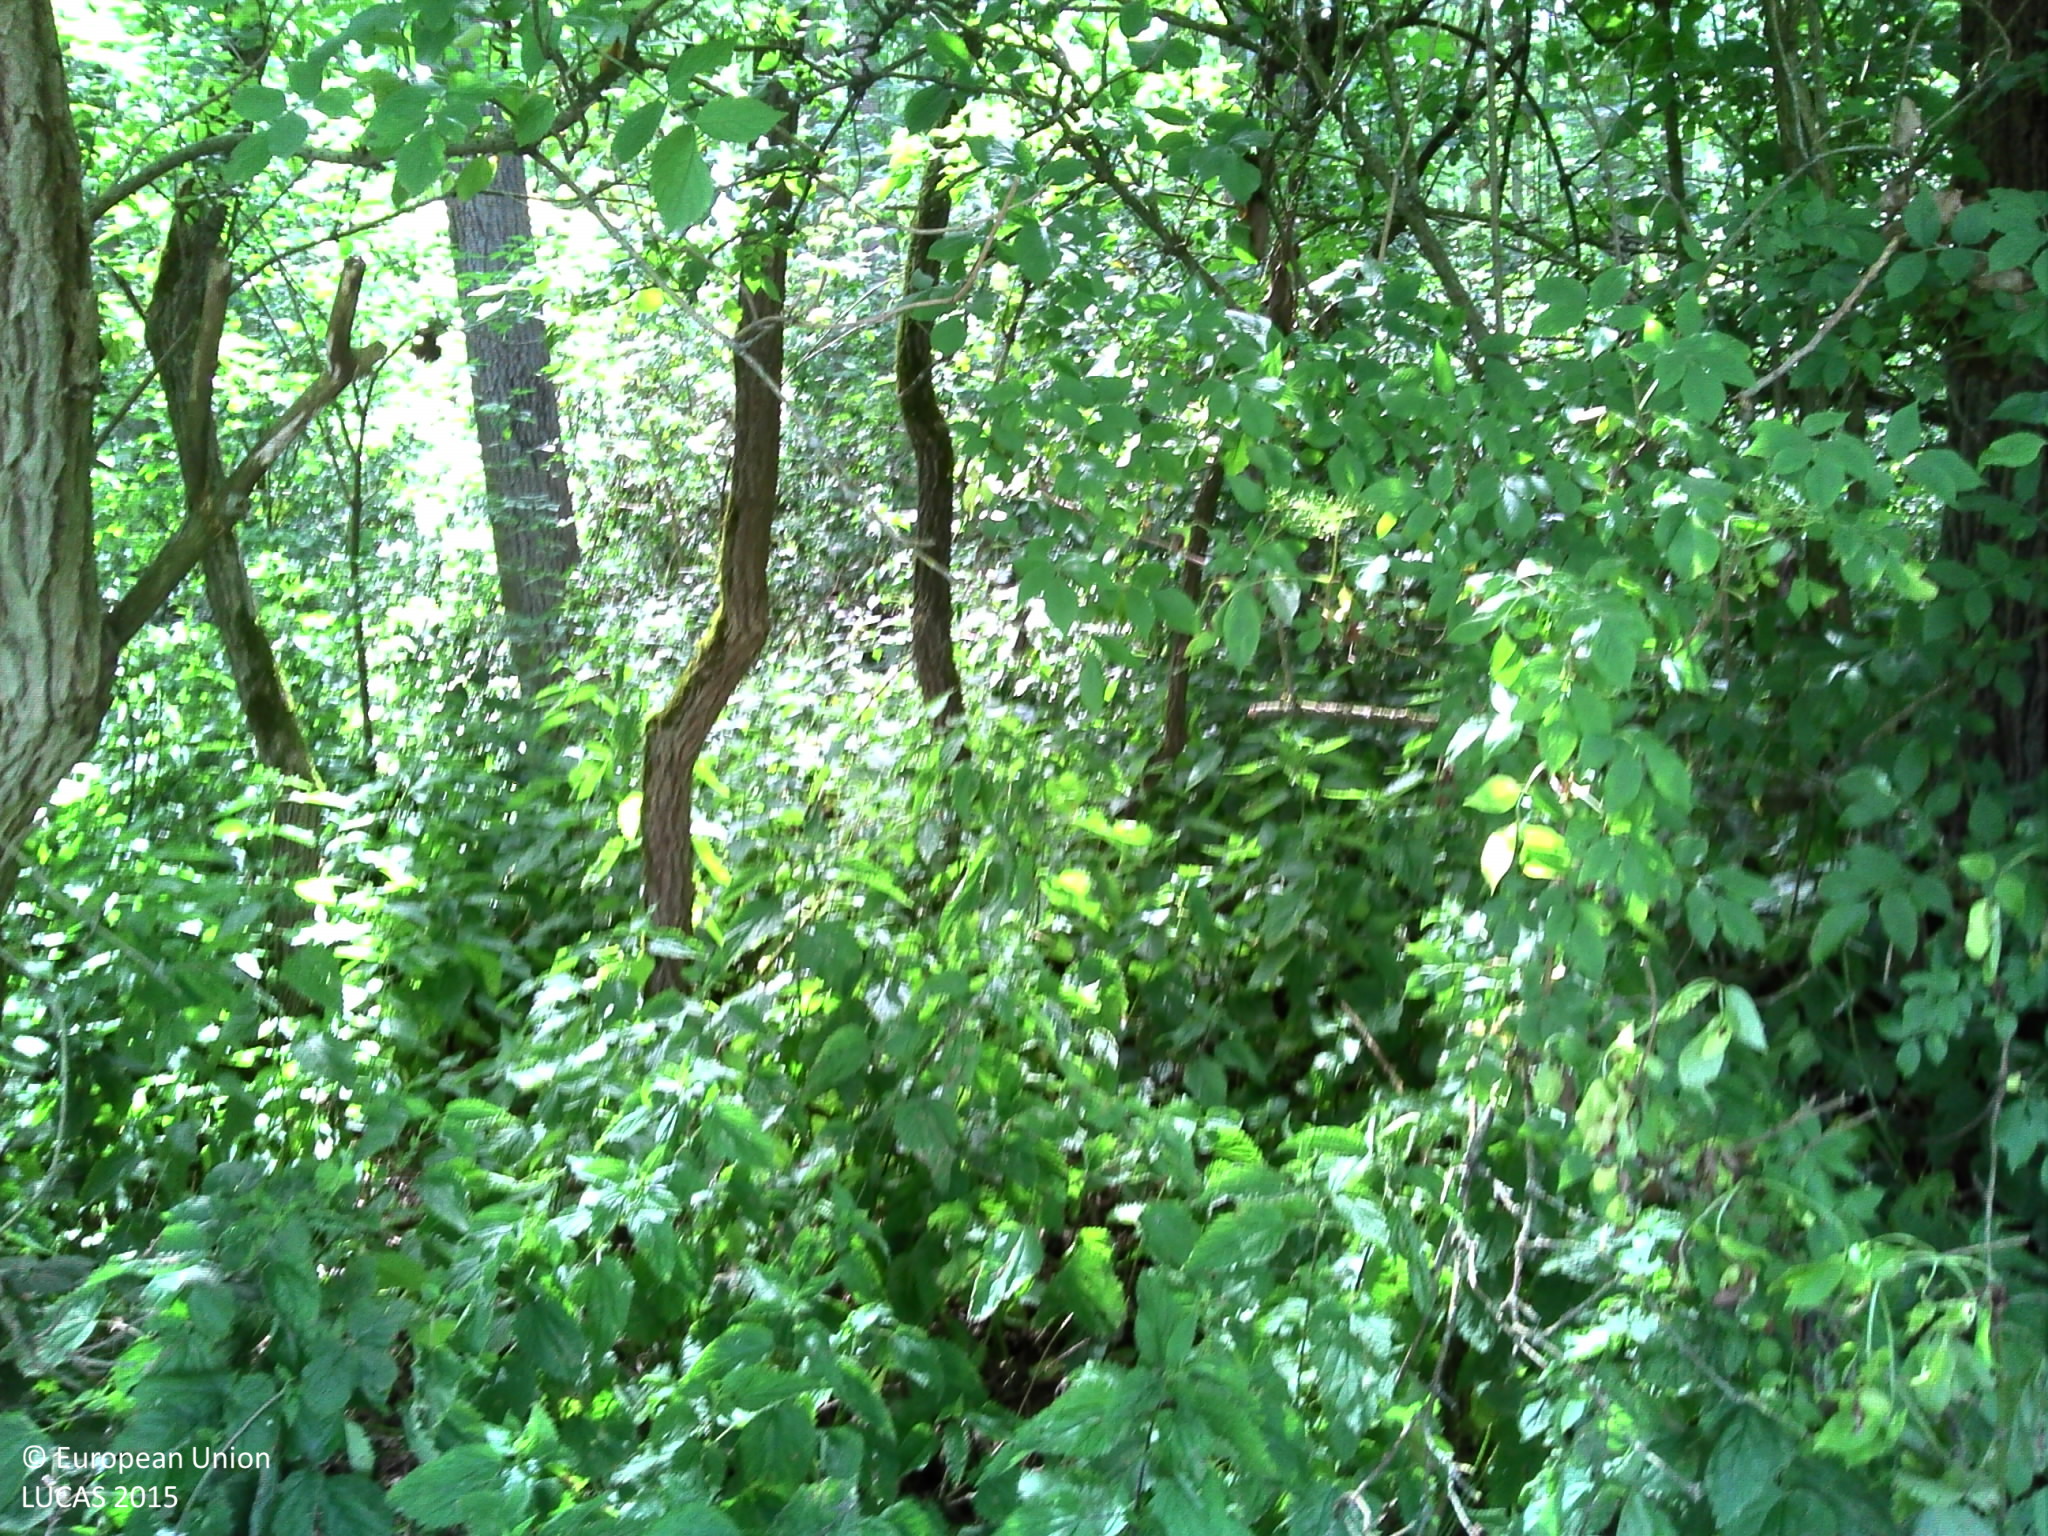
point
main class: Woodland
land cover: Spruce dominated mixed woodland
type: acidophilous oak and oak-birch forest
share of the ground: > 75 %
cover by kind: coniferous forest trees 50 %, herbaceous plants 25 %, broadleaved forest trees 20 %, shrubs 5 %
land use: Forestry
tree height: > 5 m
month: June
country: BE
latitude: 50.5144
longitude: 3.6892
